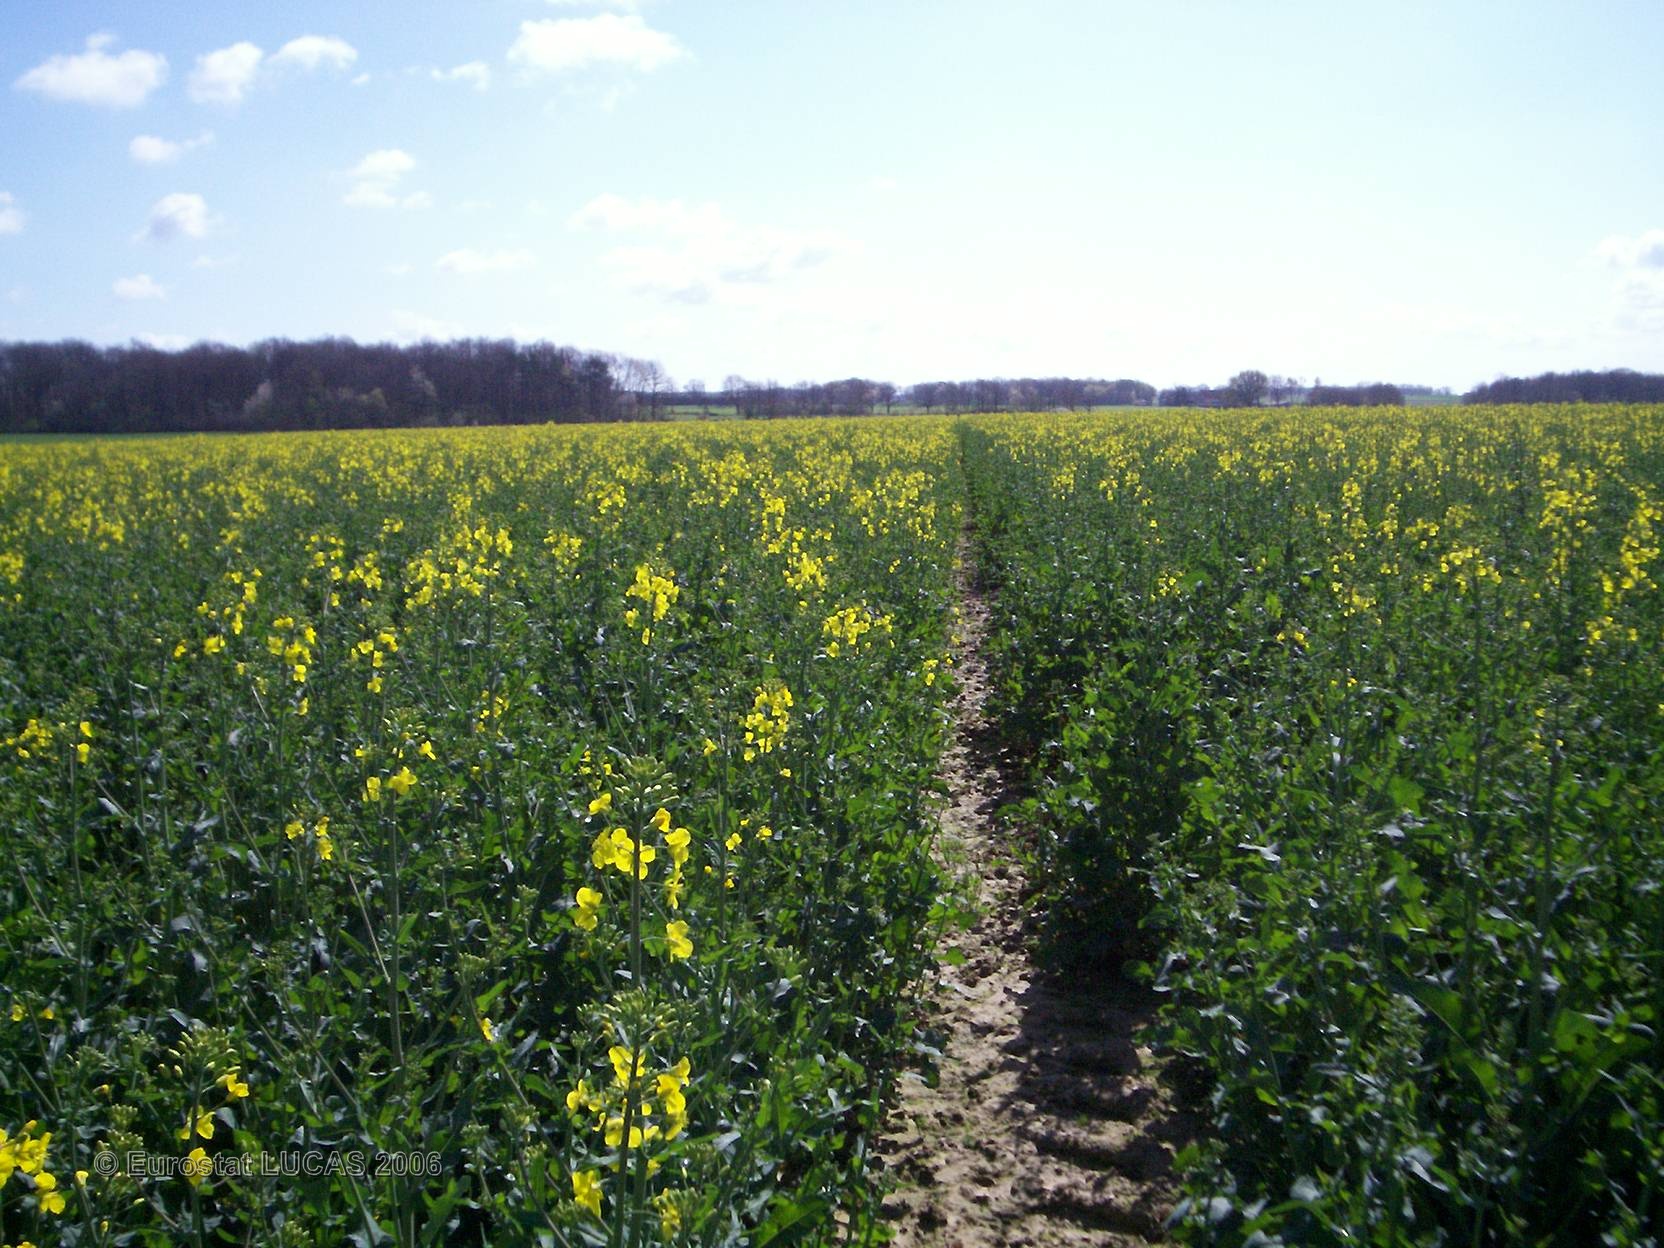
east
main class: Cropland
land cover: Rape and turnip rape
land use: Agriculture (excluding fallow land and kitchen gardens)
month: April
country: FR
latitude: 47.0017
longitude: 0.9754
